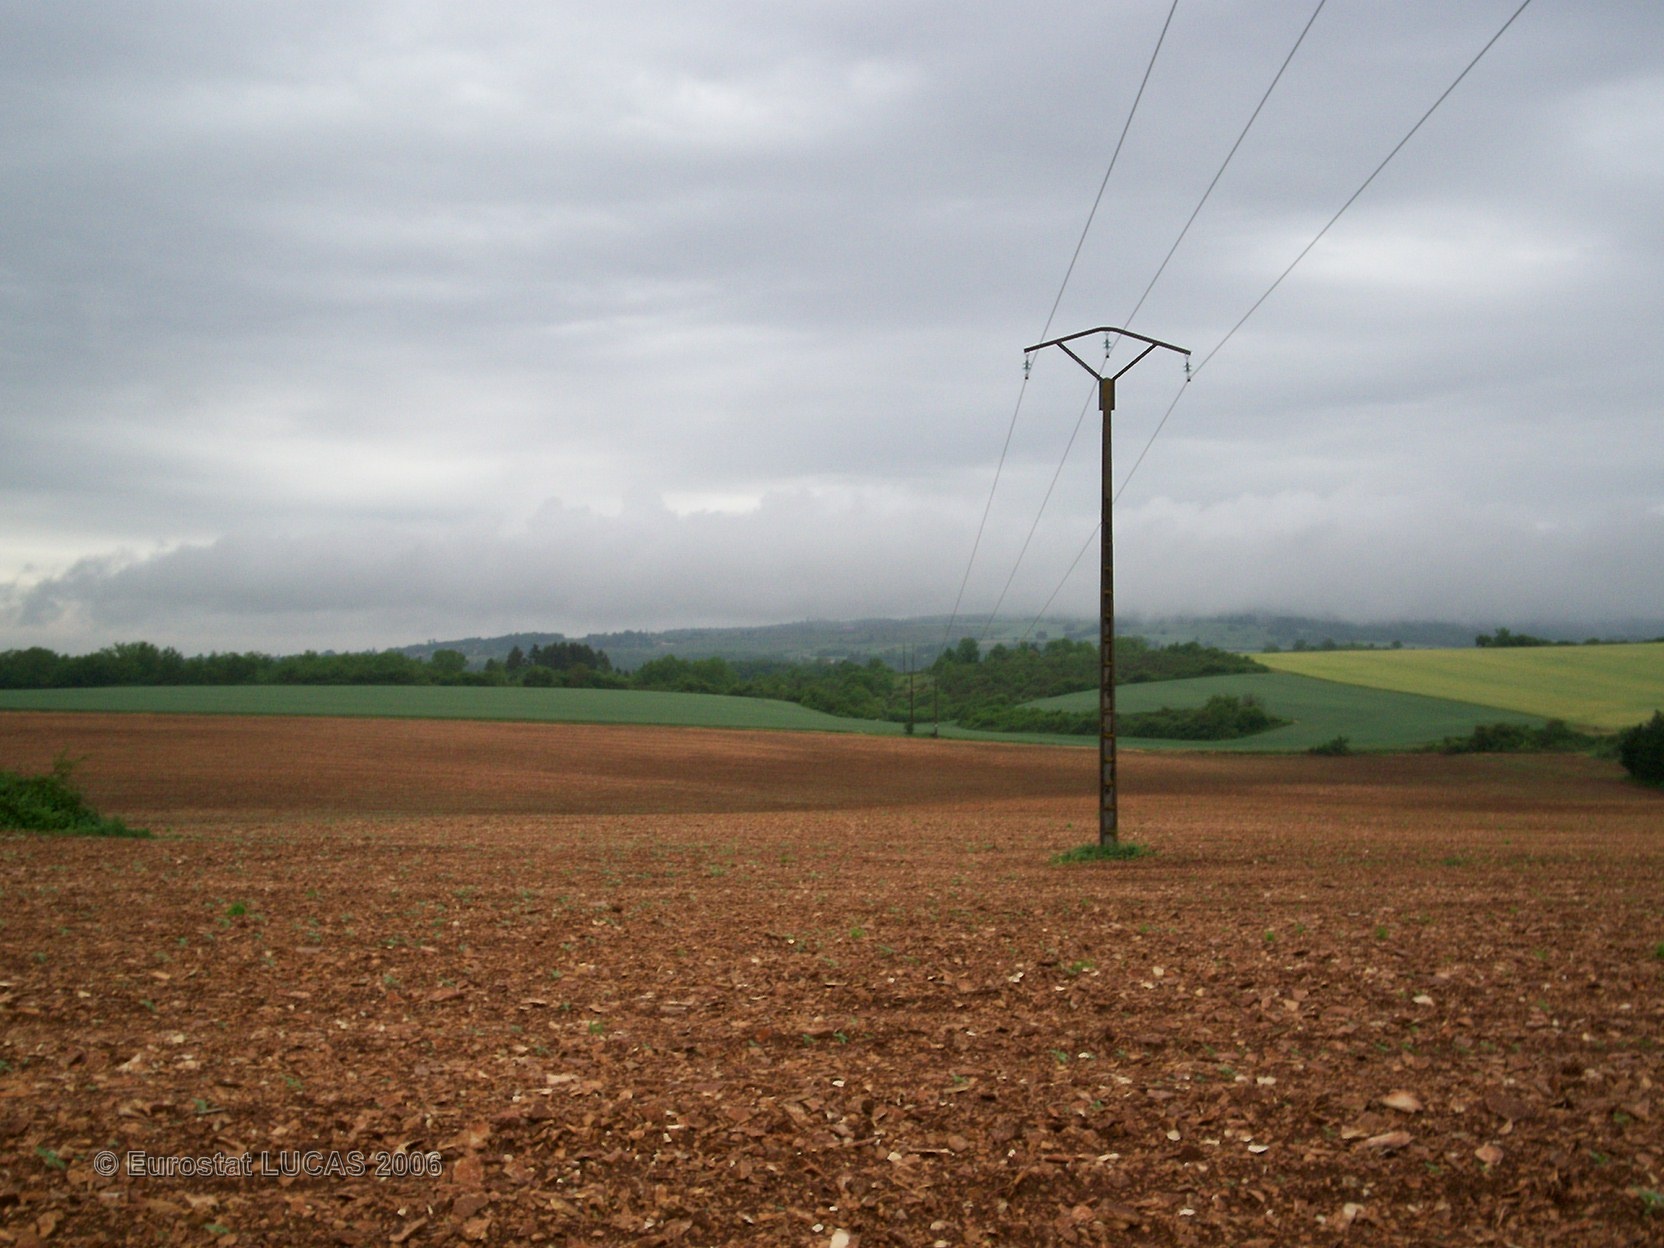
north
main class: Cropland
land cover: Sunflower
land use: Agriculture (excluding fallow land and kitchen gardens)
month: May
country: FR
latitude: 45.6558
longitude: 0.5027
